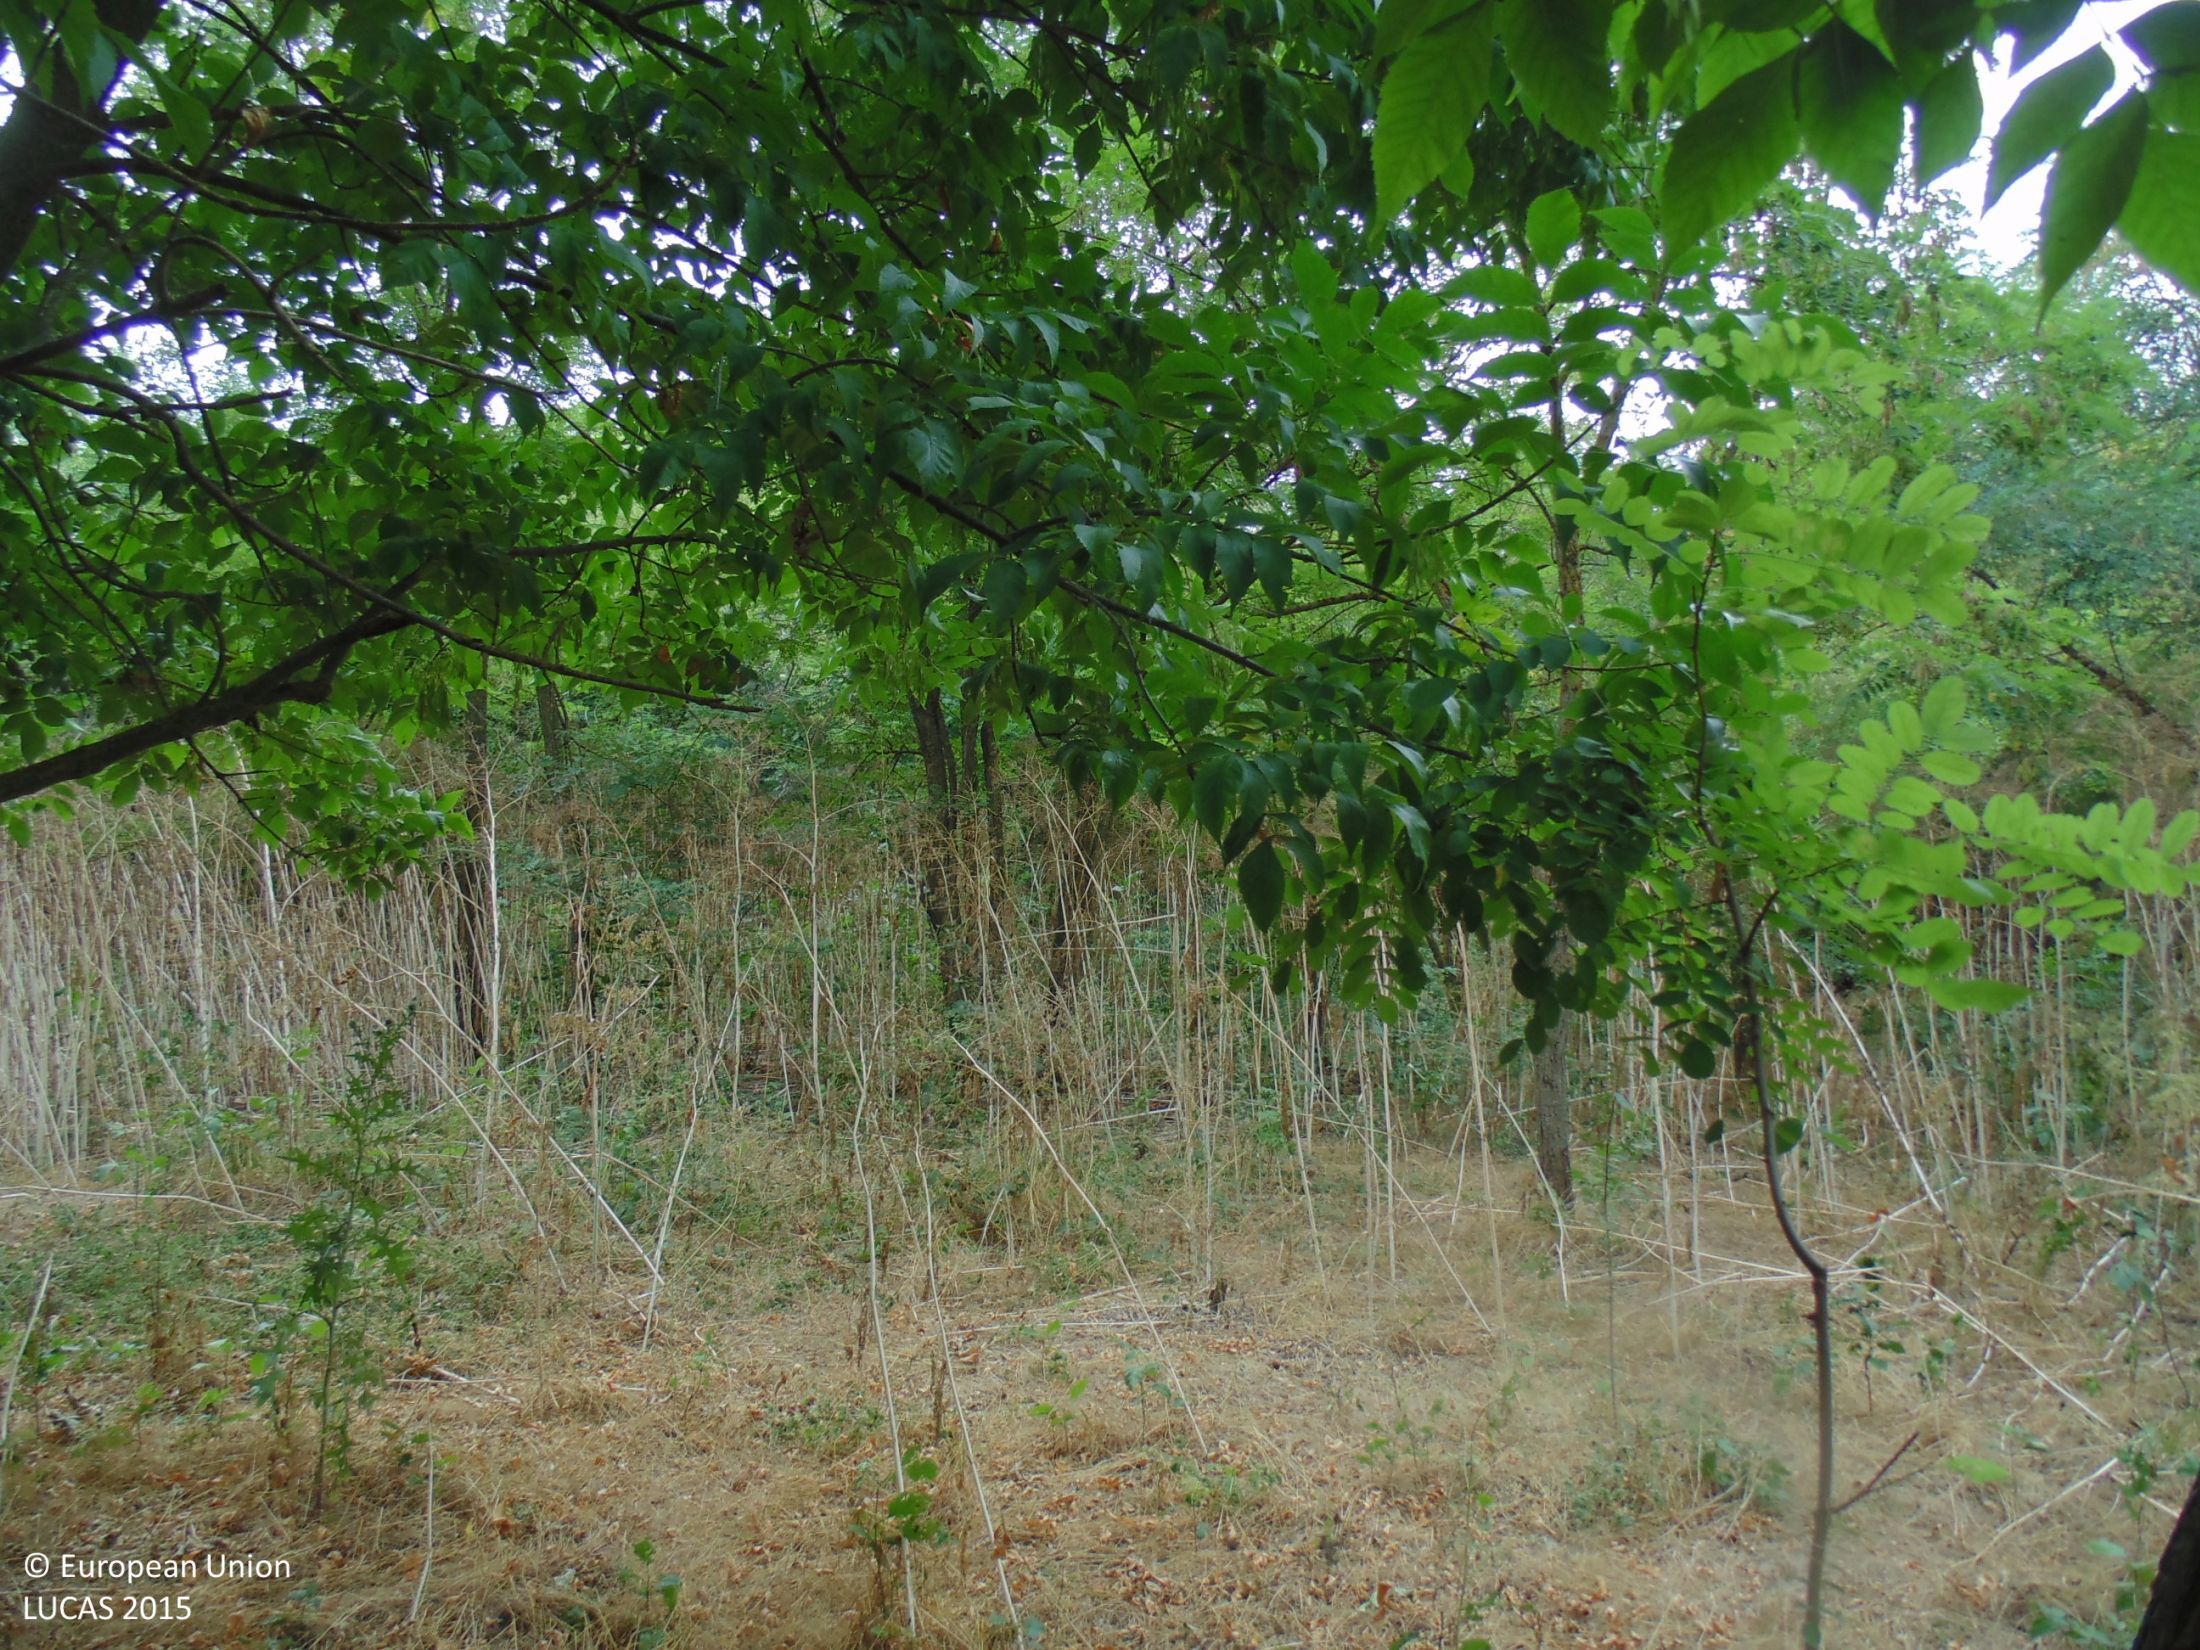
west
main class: Woodland
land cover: Broadleaved woodland
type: mesophytic deciduous forest
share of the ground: > 75 %
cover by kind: broadleaved forest trees 90 %, shrubs 10 %
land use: Forestry
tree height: > 5 m
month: August
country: BG
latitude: 43.5695
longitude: 28.5248
